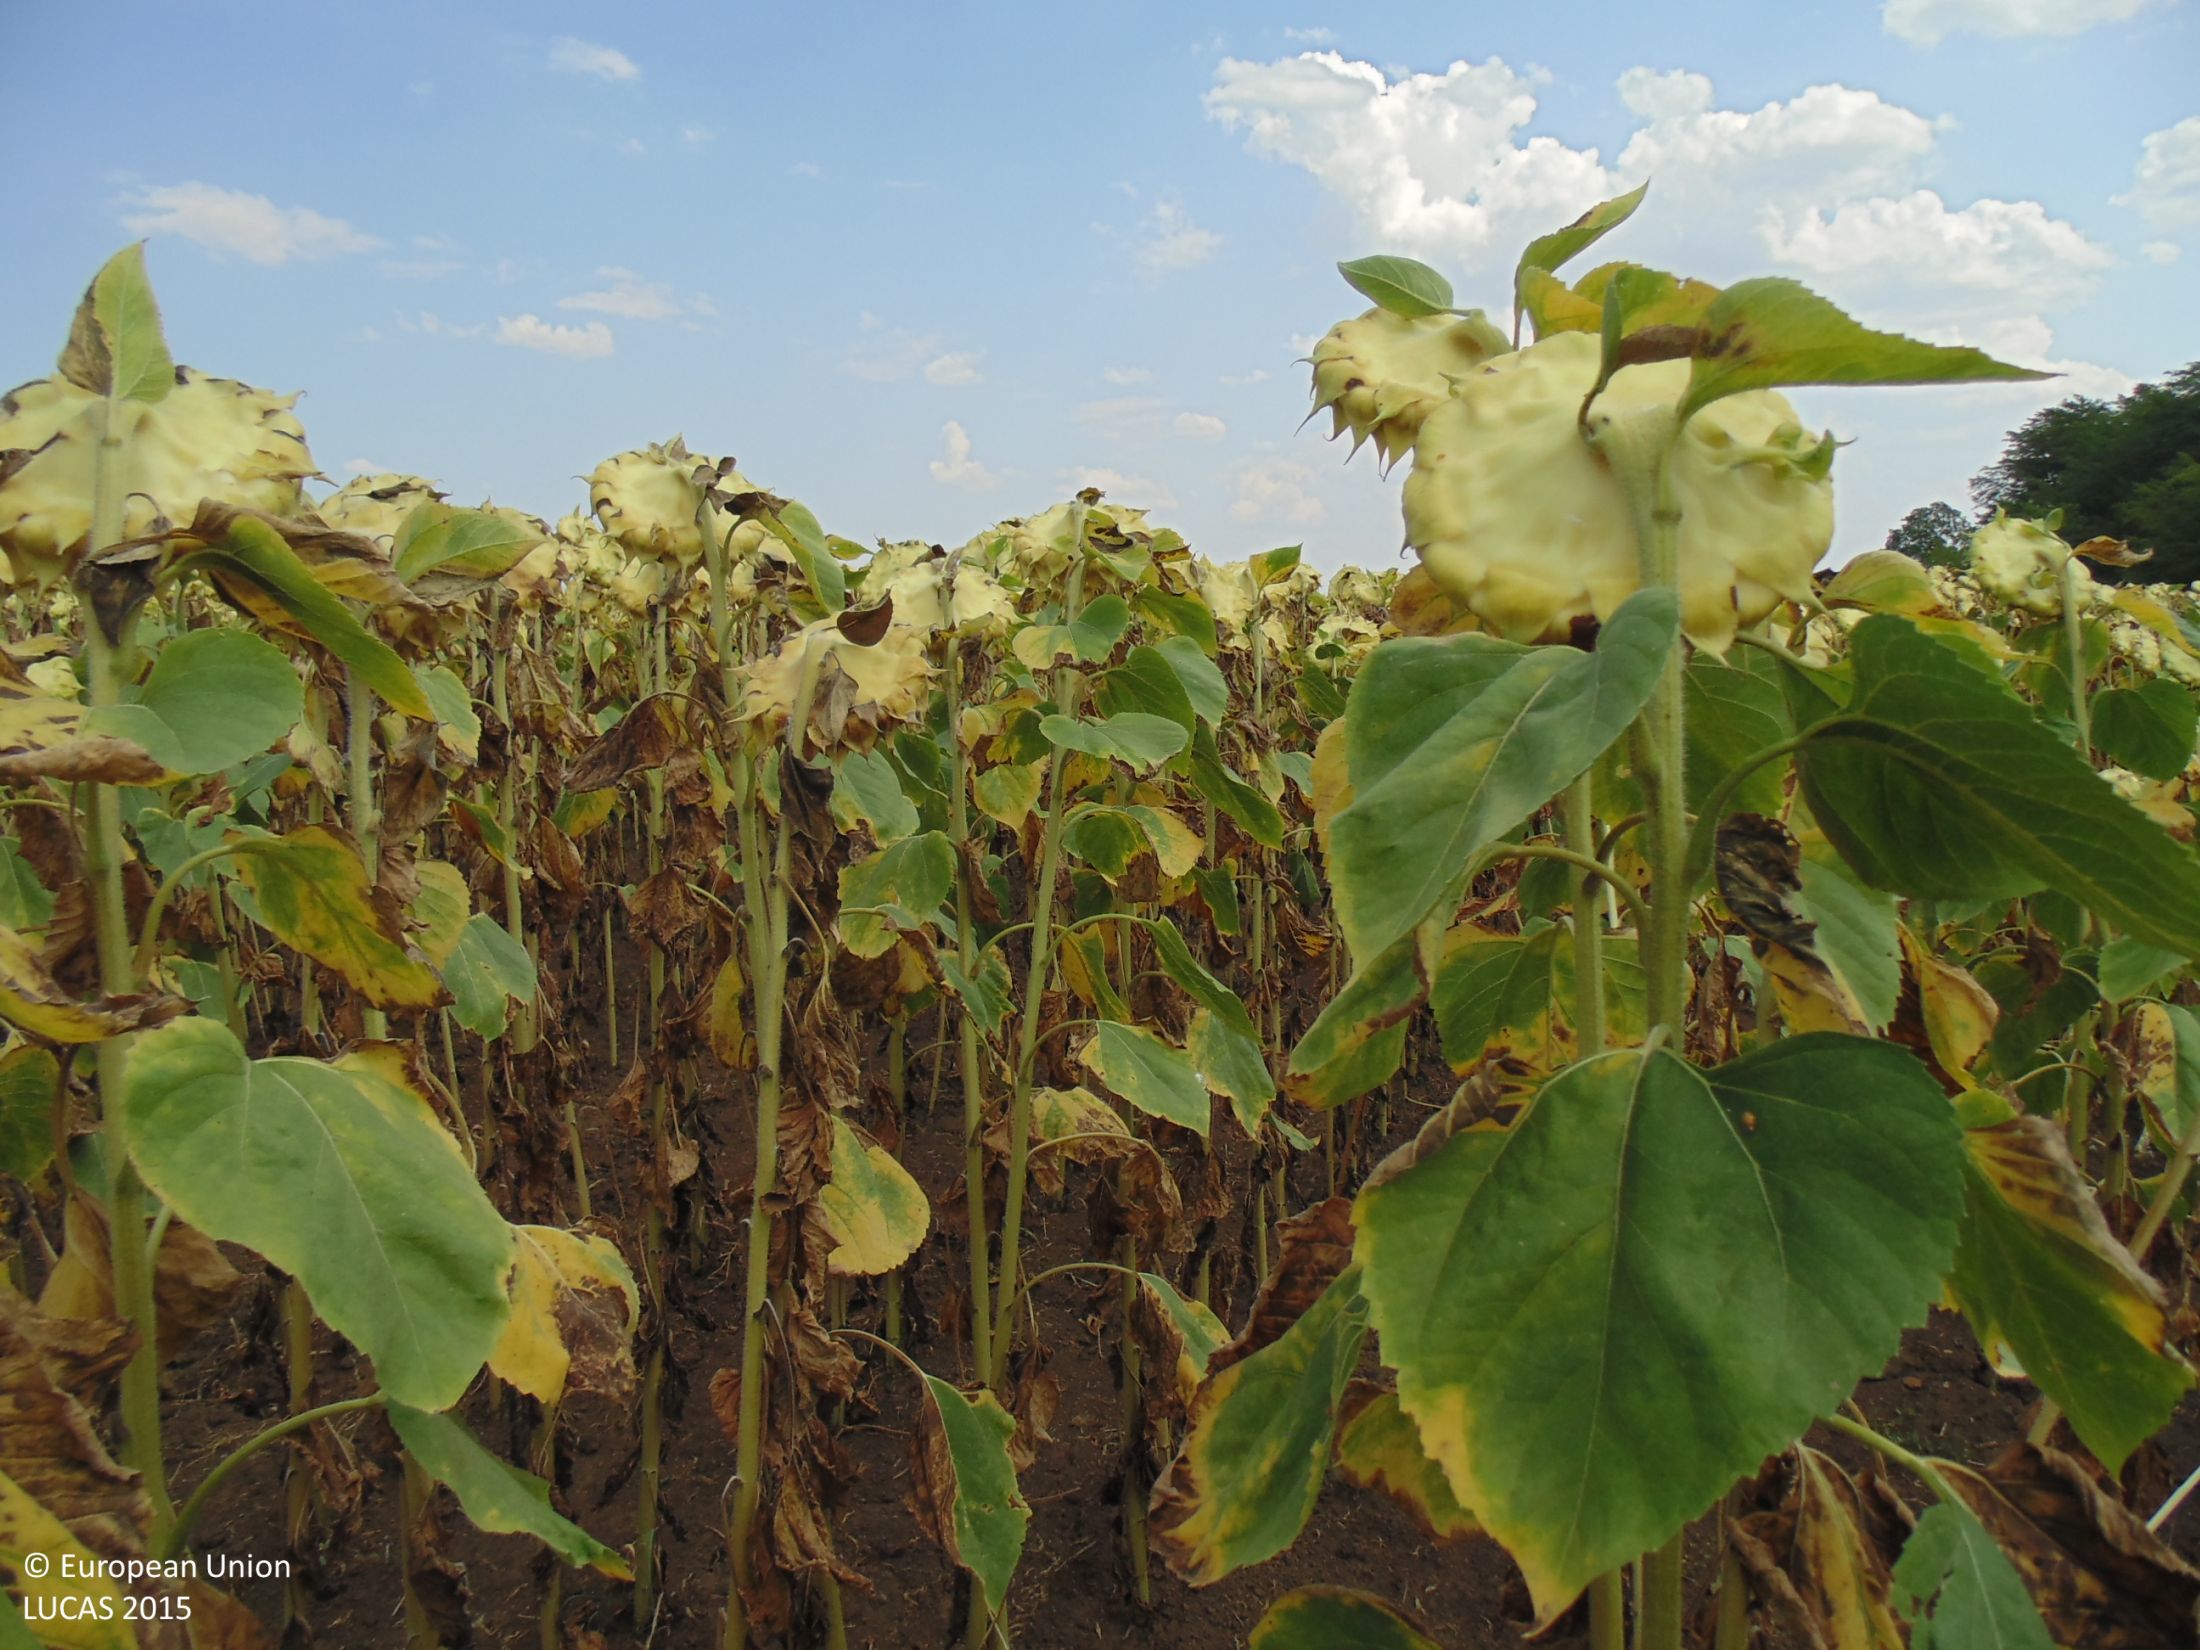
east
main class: Cropland
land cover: Sunflower
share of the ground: > 75 %
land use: Agriculture (excluding fallow land and kitchen gardens)
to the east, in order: Sunflower
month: August
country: BG
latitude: 43.8596
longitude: 27.5168
